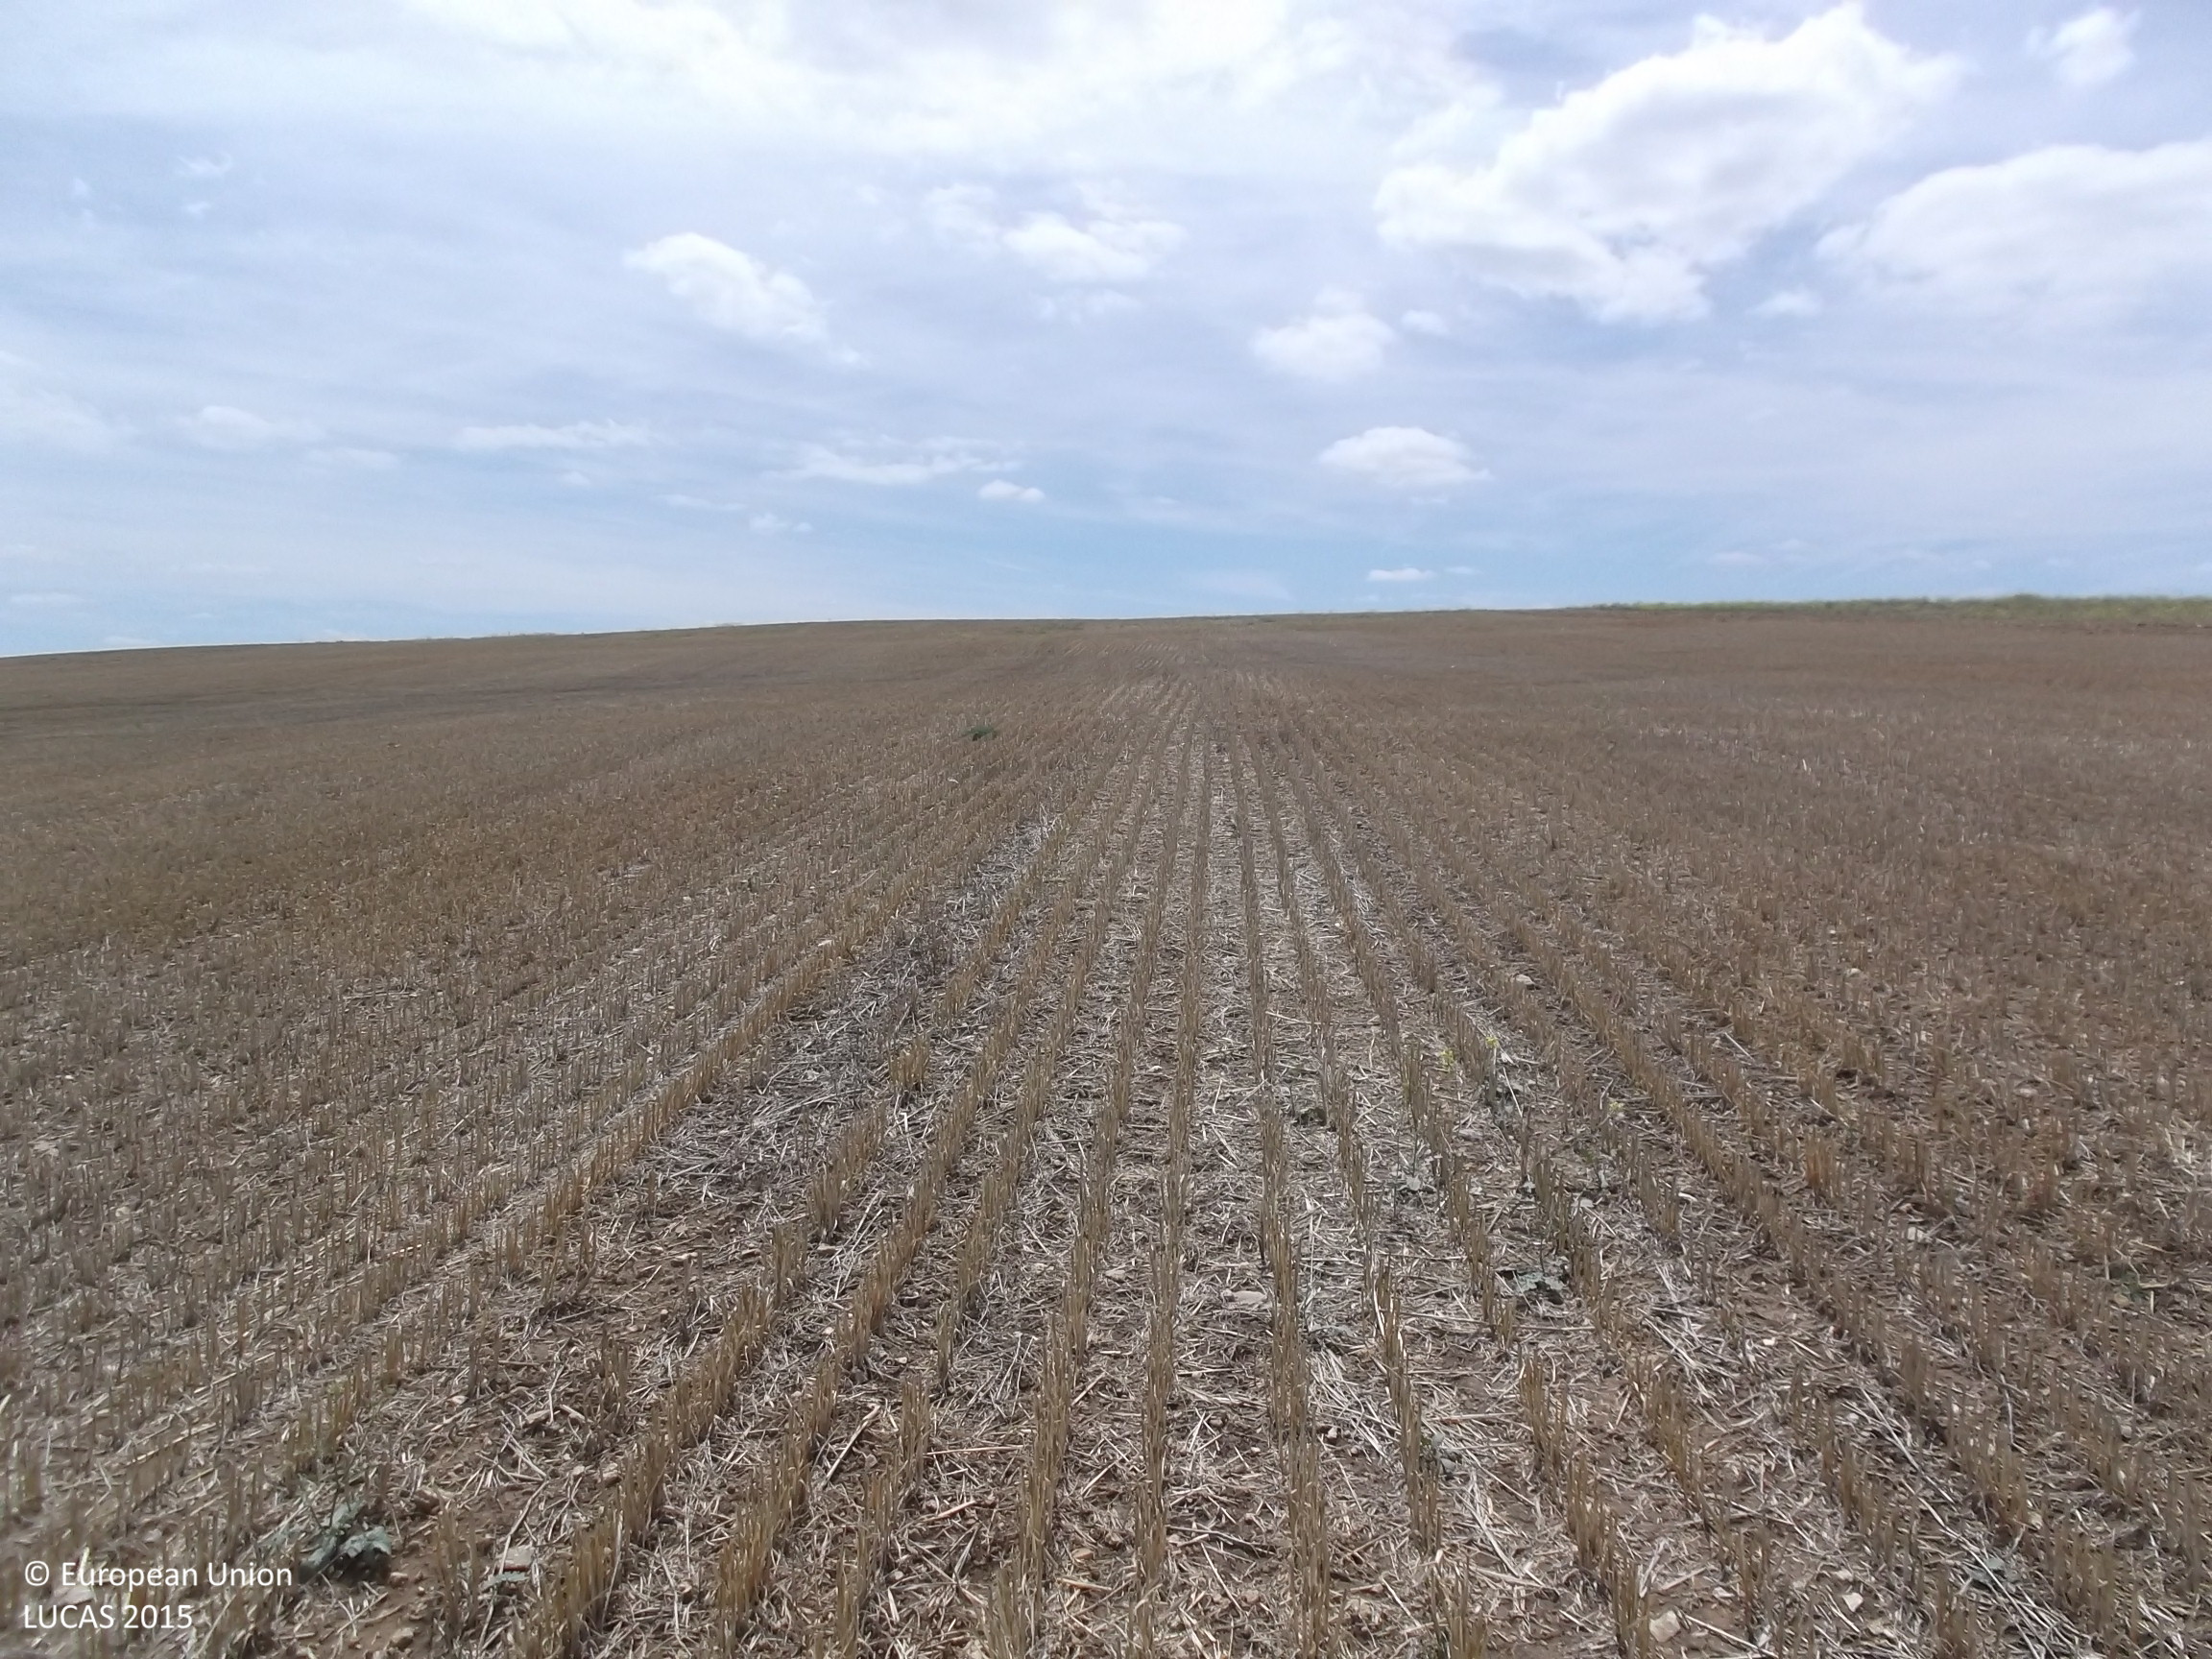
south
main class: Cropland
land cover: Oats
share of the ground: < 10 %
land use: Agriculture (excluding fallow land and kitchen gardens)
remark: Harvested field
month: August
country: ES
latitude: 42.4678
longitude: -2.1428
